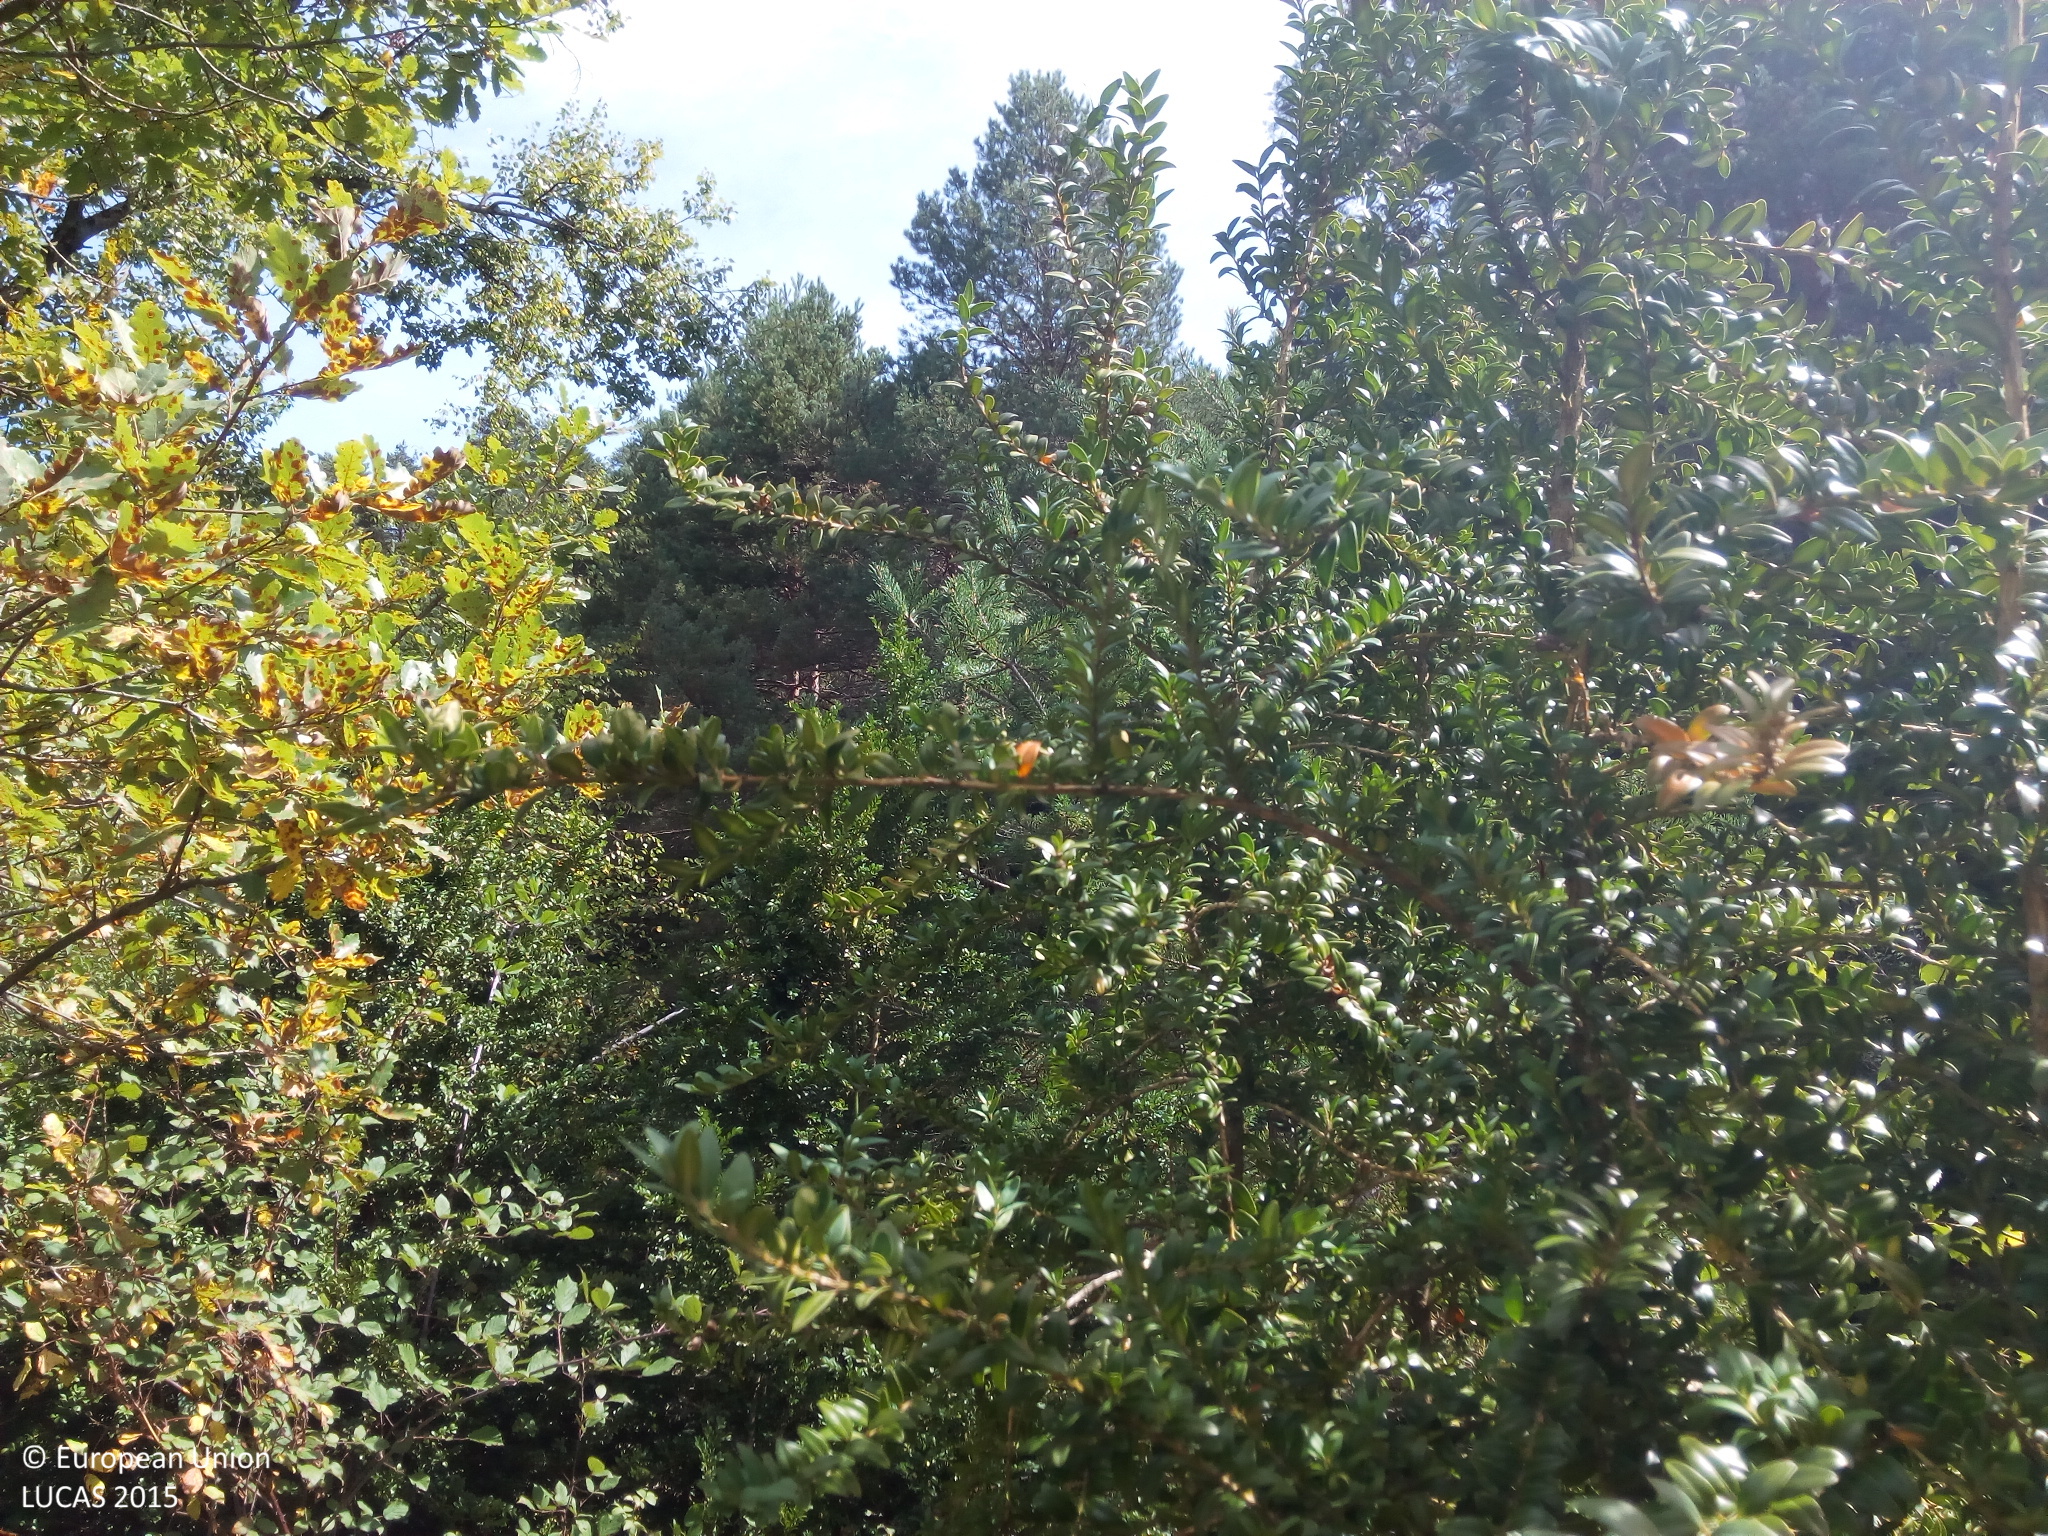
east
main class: Woodland
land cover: Pine dominated coniferous woodland
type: coniferous forest of the mediterranean region
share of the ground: > 75 %
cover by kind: coniferous forest trees 75 %, shrubs 25 %
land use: Semi-natural and natural areas not in use
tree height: > 5 m
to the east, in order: Pine dominated coniferous woodland; Tracks; Pine dominated coniferous woodland
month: September
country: ES
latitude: 42.4415
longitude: 0.4859
